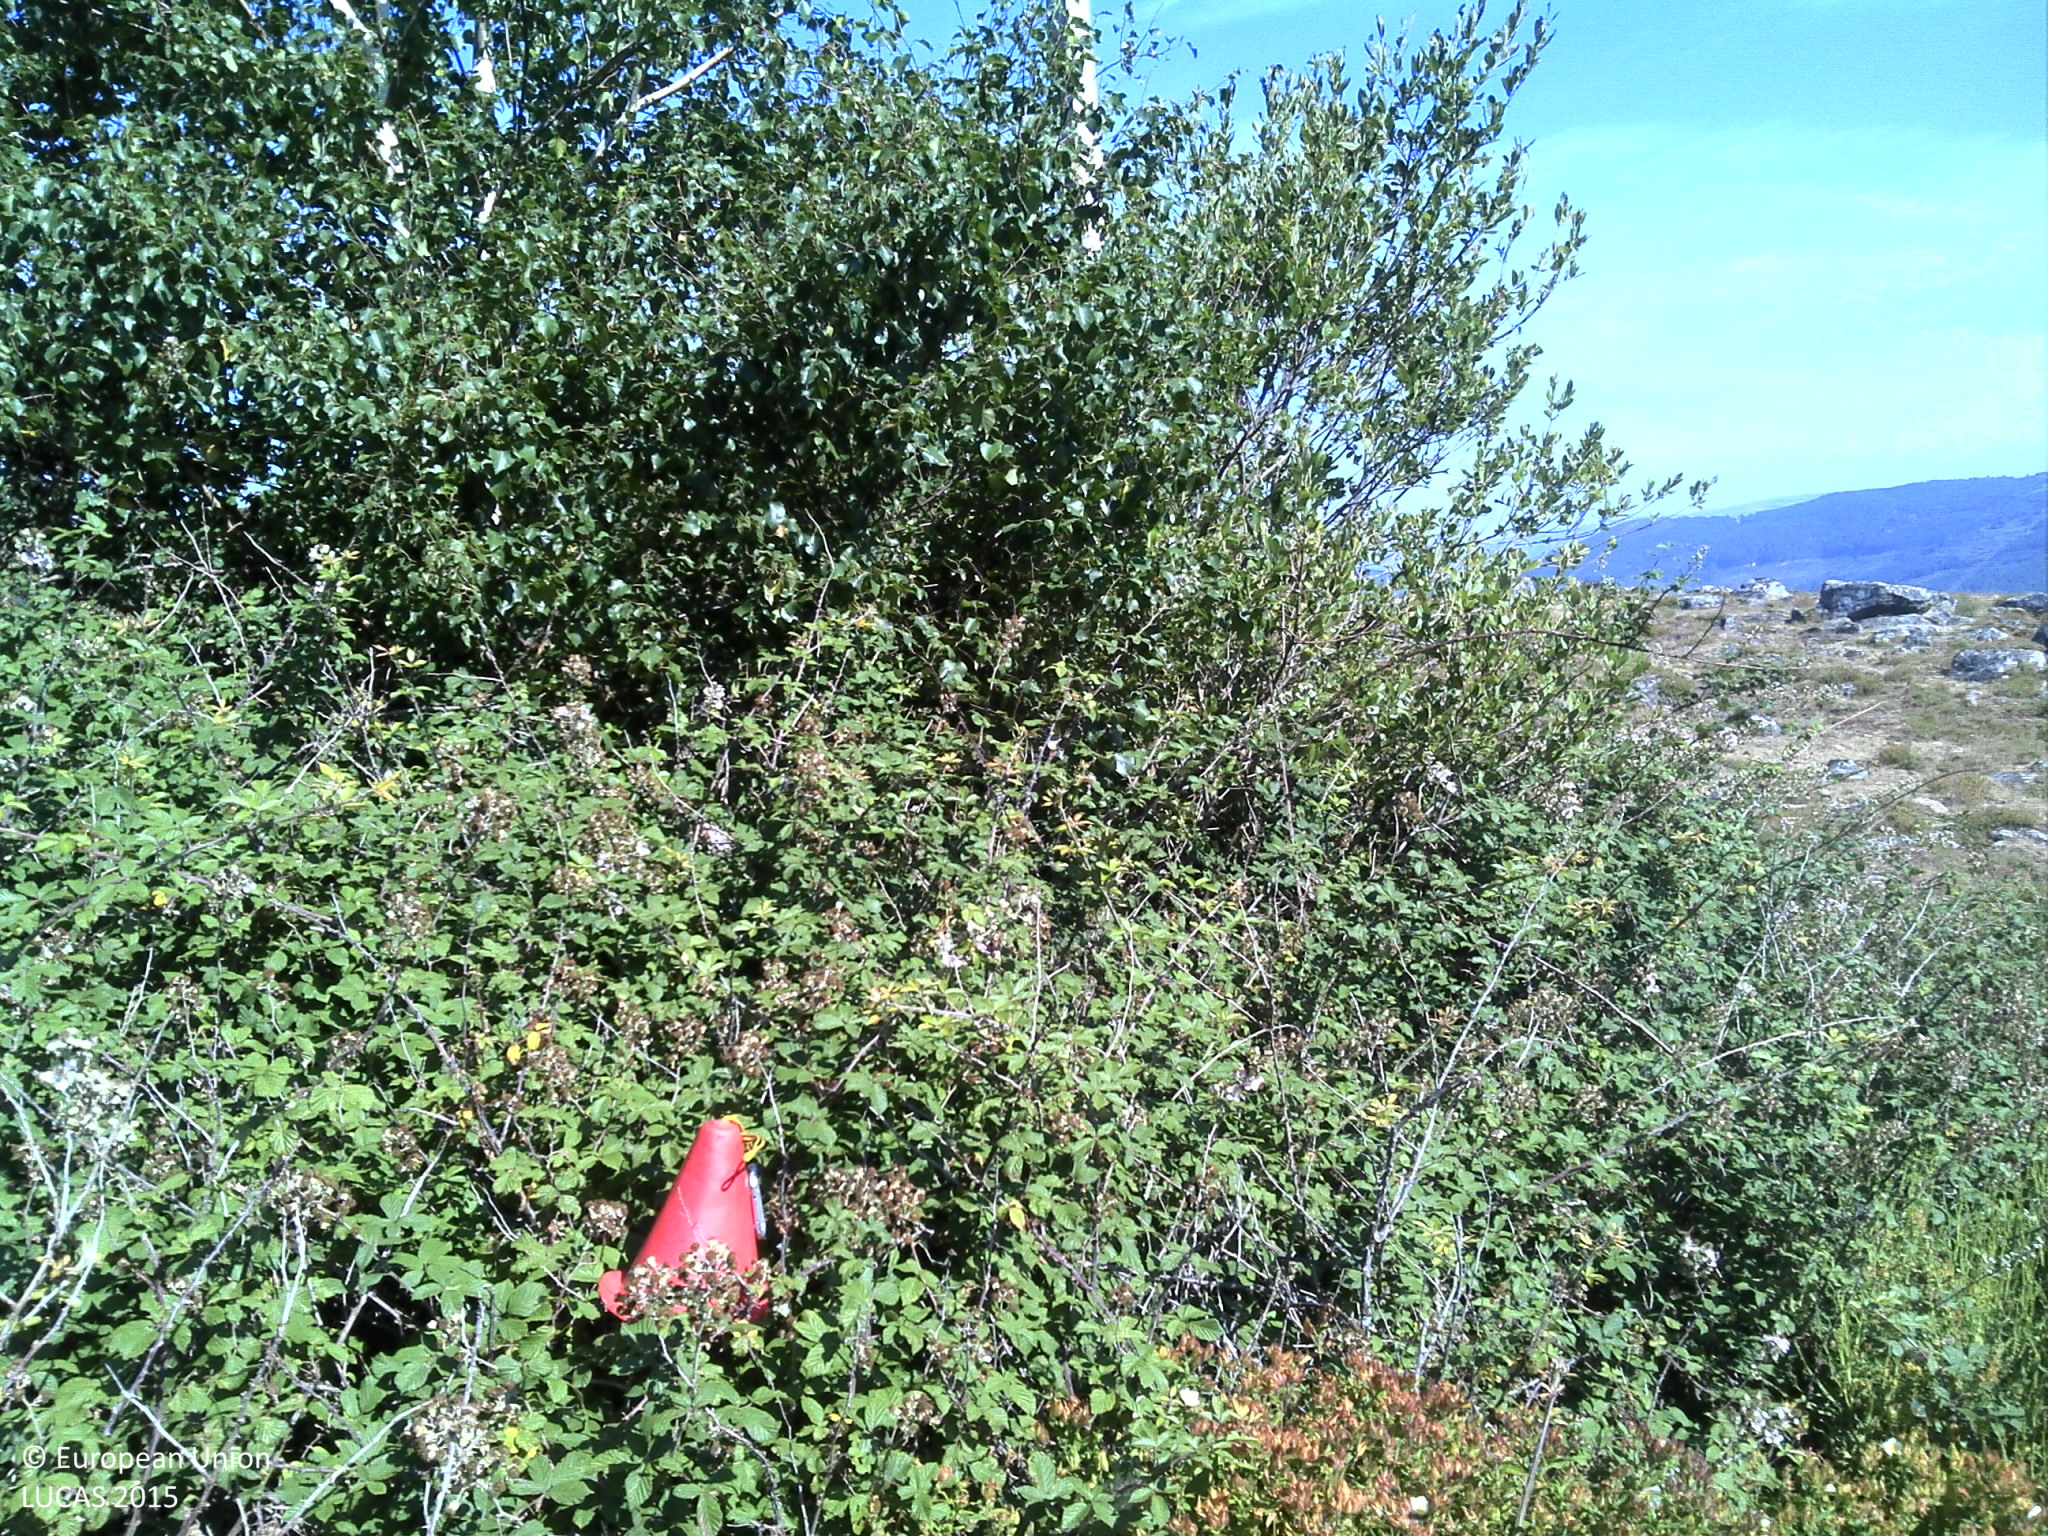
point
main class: Shrubland
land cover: Shrubland without tree cover
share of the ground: > 75 %
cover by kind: shrubs 90 %, consolidated bare surface 5 %, unconsolidated bare surface 5 %
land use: Agriculture (excluding fallow land and kitchen gardens)
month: July
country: PT
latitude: 41.4472
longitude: -7.8141
